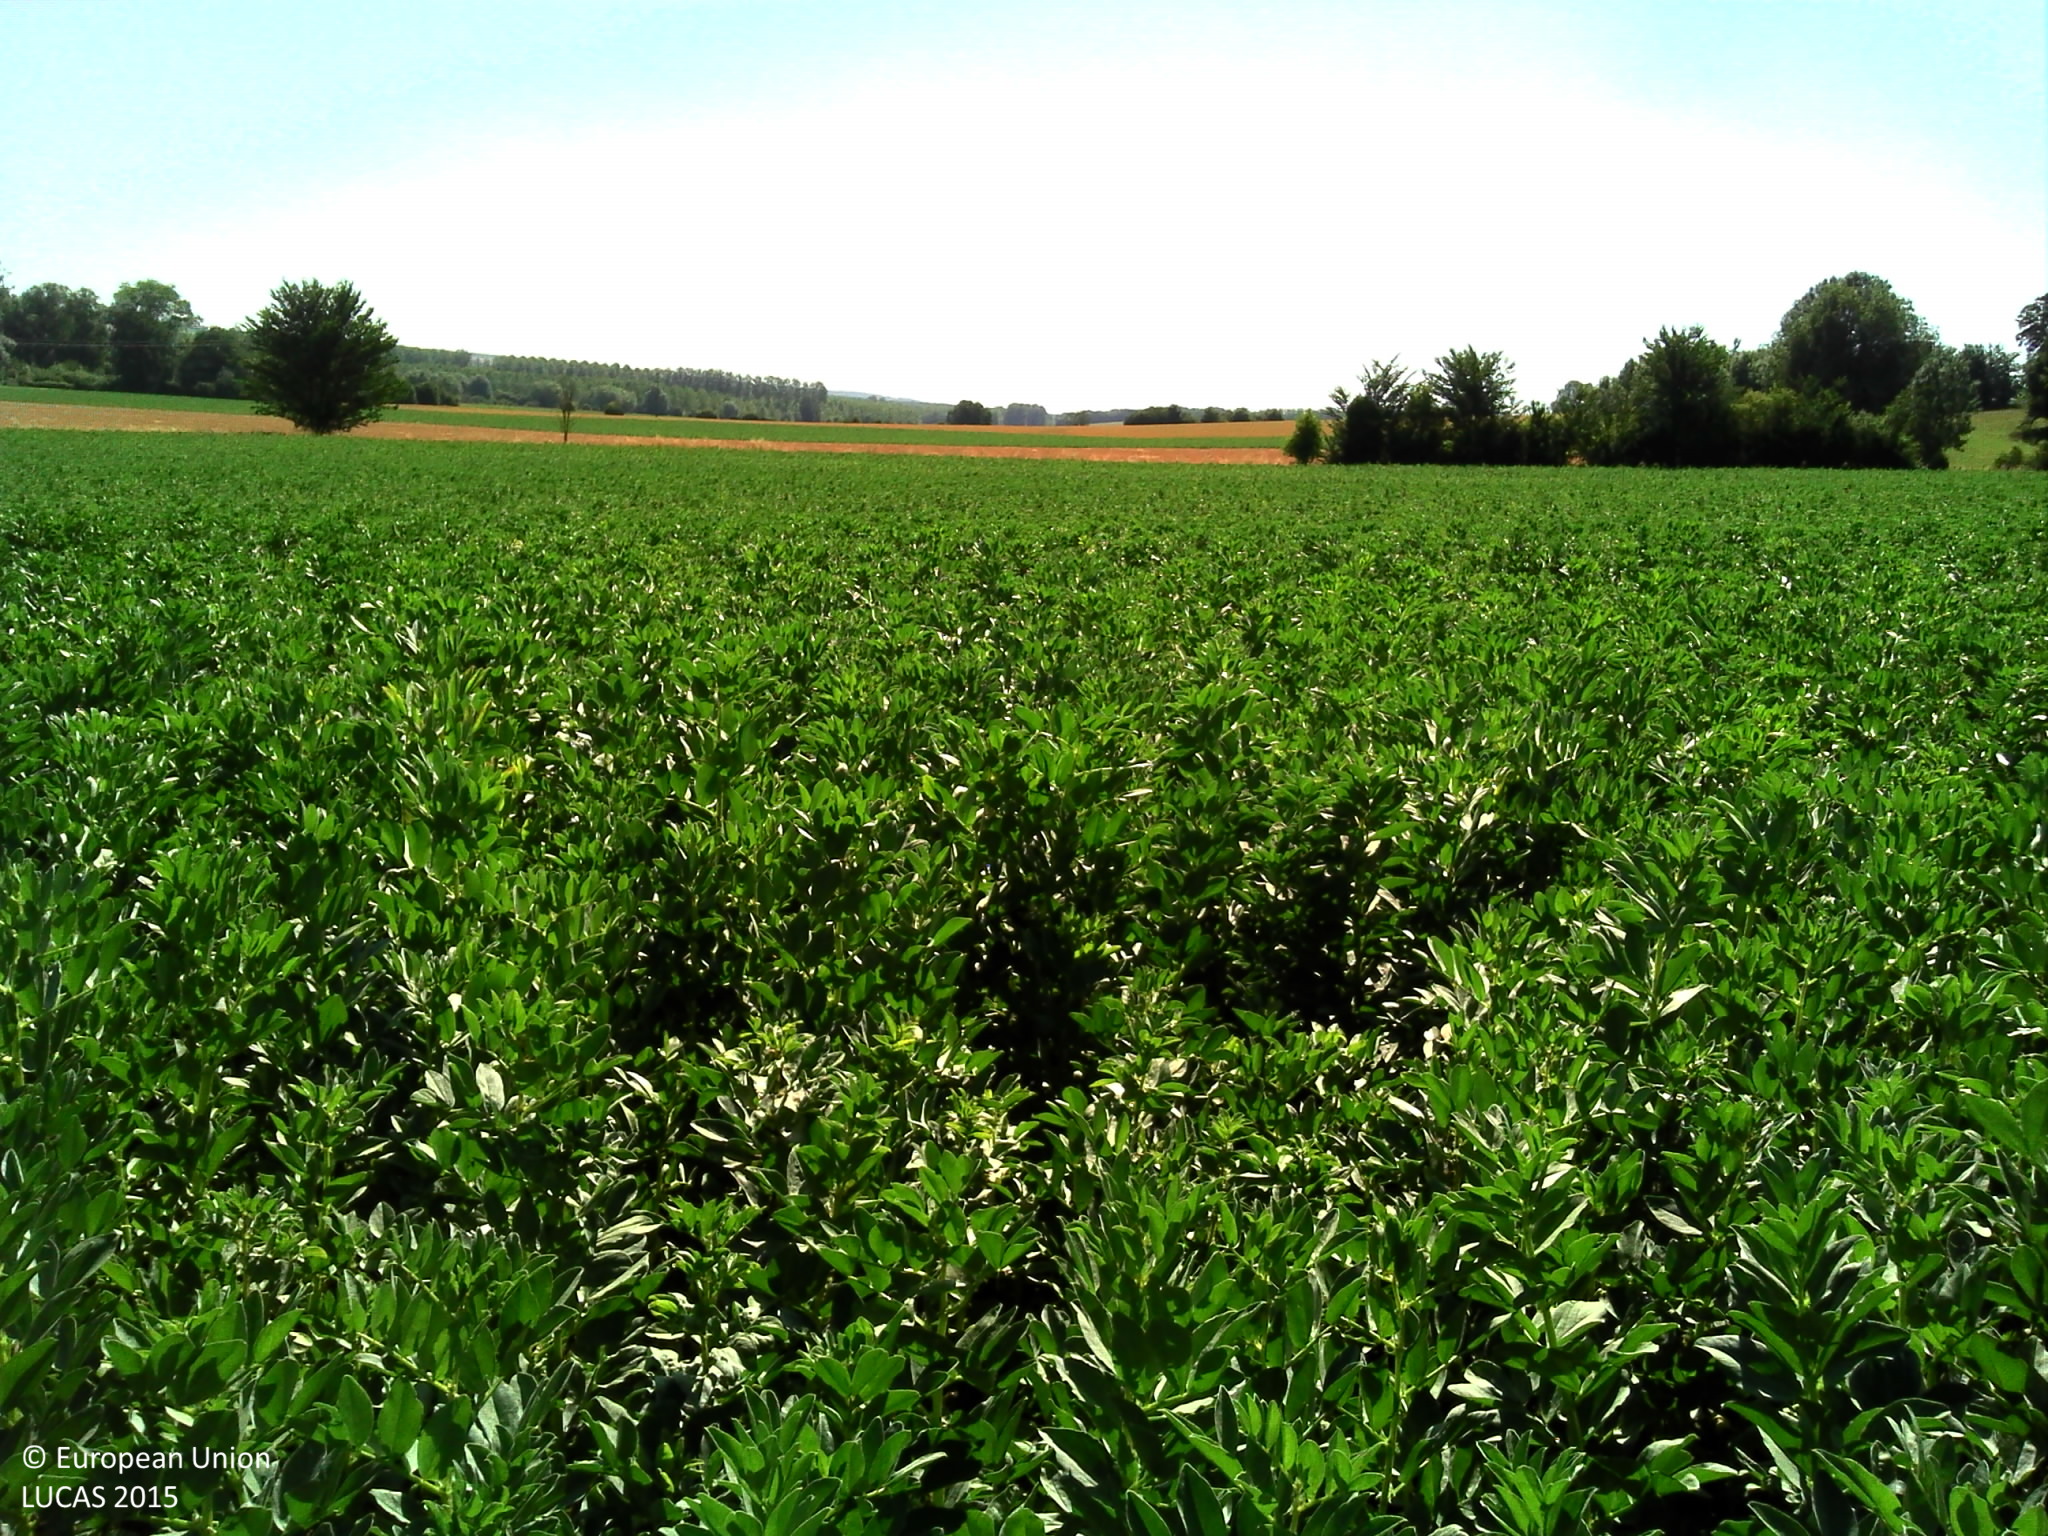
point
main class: Cropland
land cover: Dry pulses
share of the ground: > 75 %
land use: Agriculture (excluding fallow land and kitchen gardens)
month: July
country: FR
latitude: 50.2186
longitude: 2.1228
